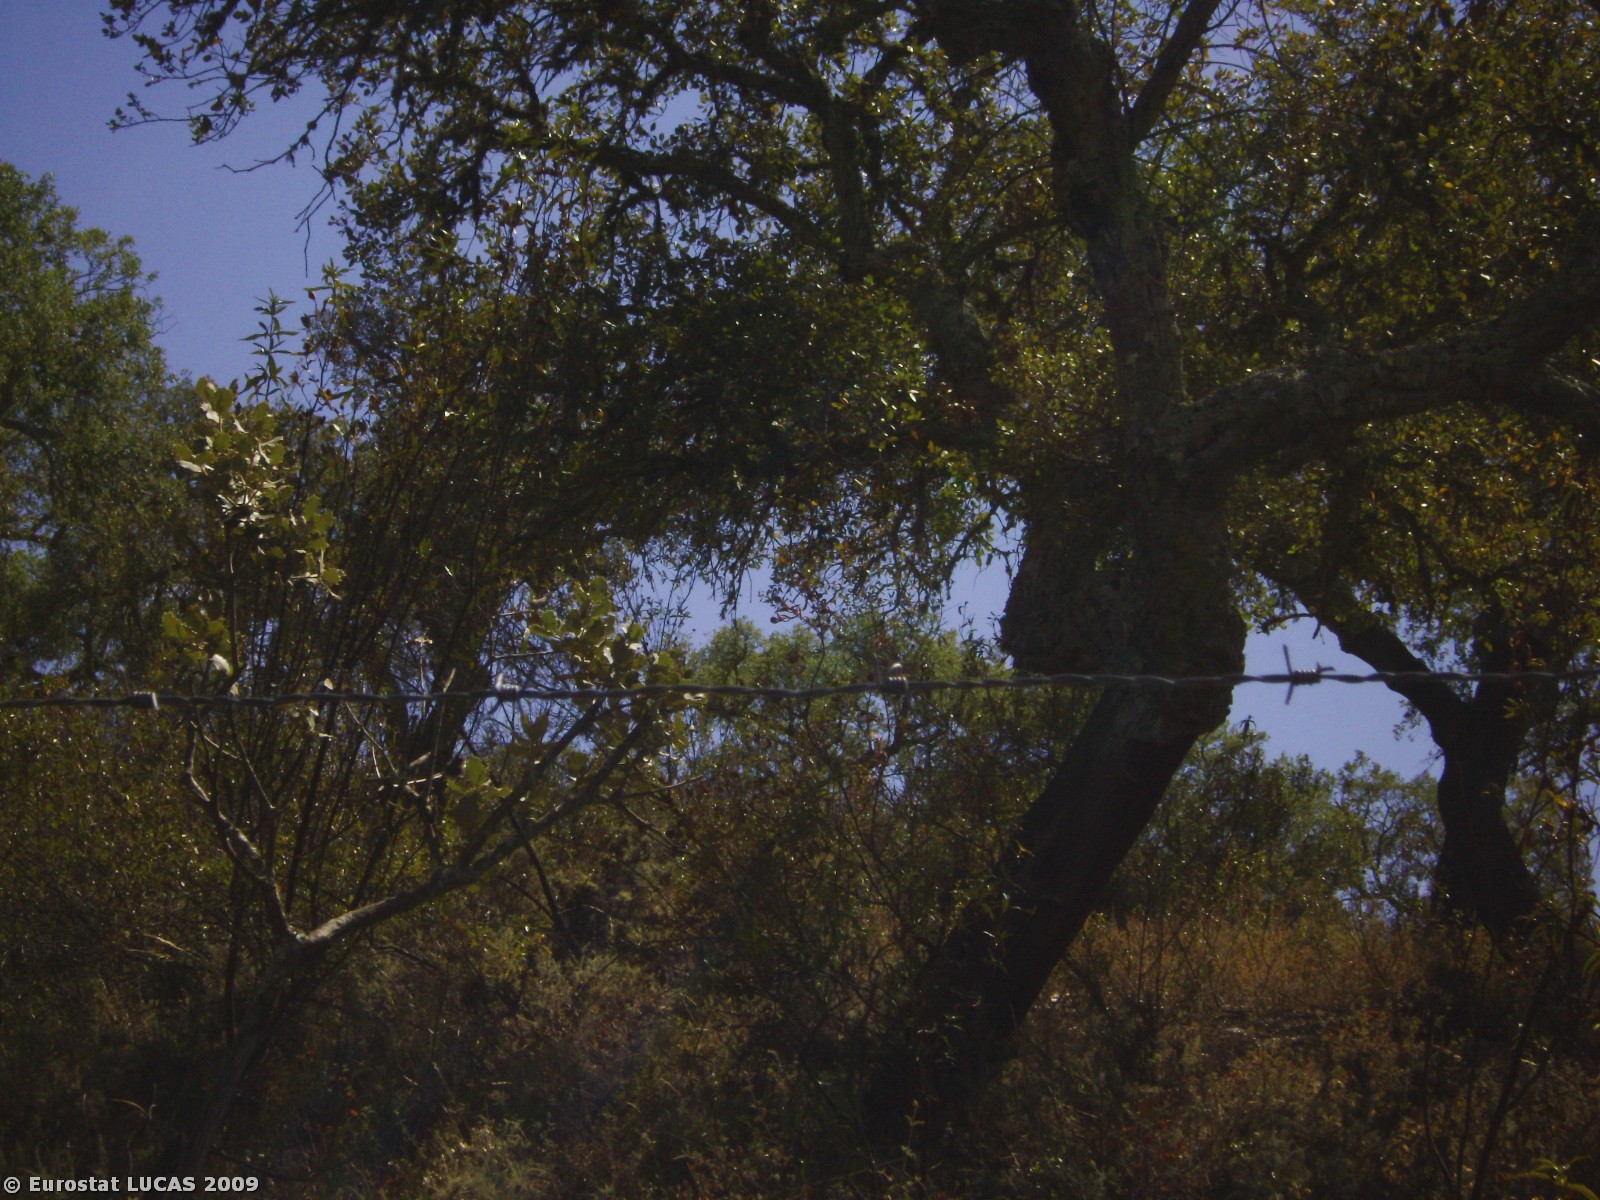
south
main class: Woodland
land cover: Broadleaved woodland
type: broadleaved evergreen forest
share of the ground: 50 - 75 %
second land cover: Shrubland with sparse tree cover
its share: 50 - 75 %
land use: Forestry
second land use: Unused
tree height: > 5 m
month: August
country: PT
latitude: 38.0668
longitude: -7.1211
